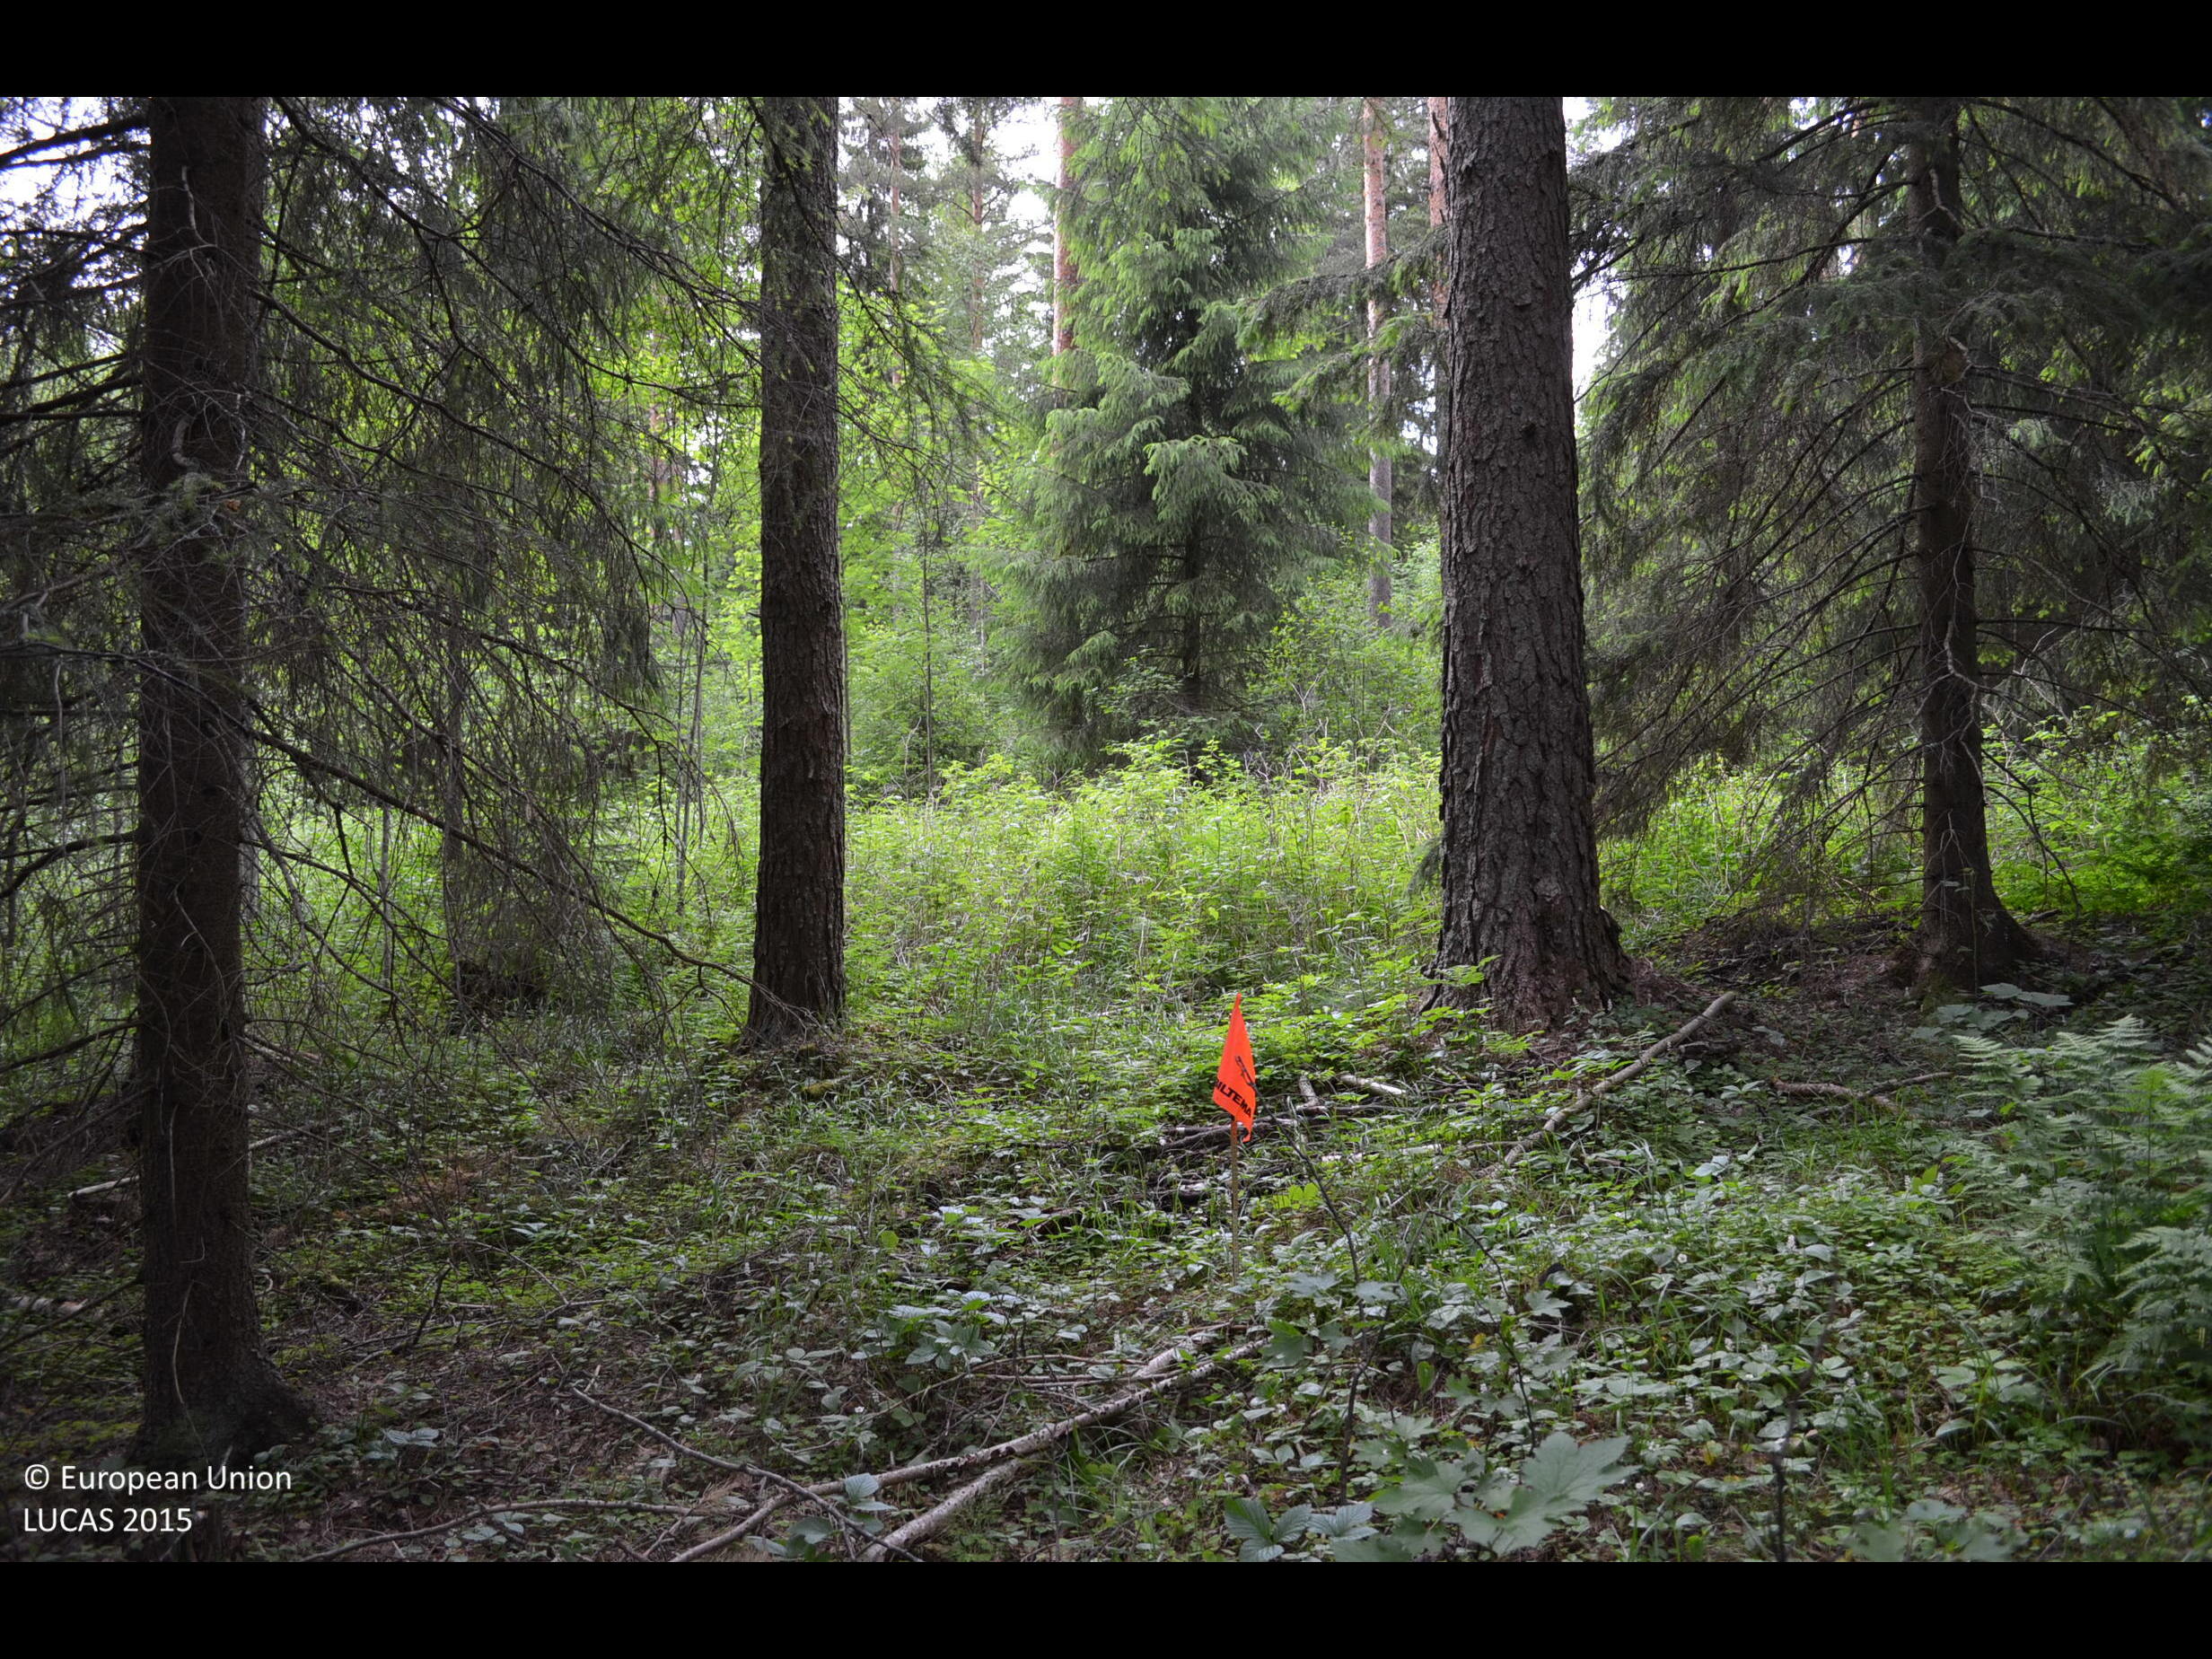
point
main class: Woodland
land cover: Other mixed woodland
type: boreal forest
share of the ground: > 75 %
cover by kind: coniferous forest trees 50 %, broadleaved forest trees 35 %, shrubs 10 %, herbaceous plants 5 %
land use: Forestry
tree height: > 5 m
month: June
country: FI
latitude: 61.8103
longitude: 23.3769
